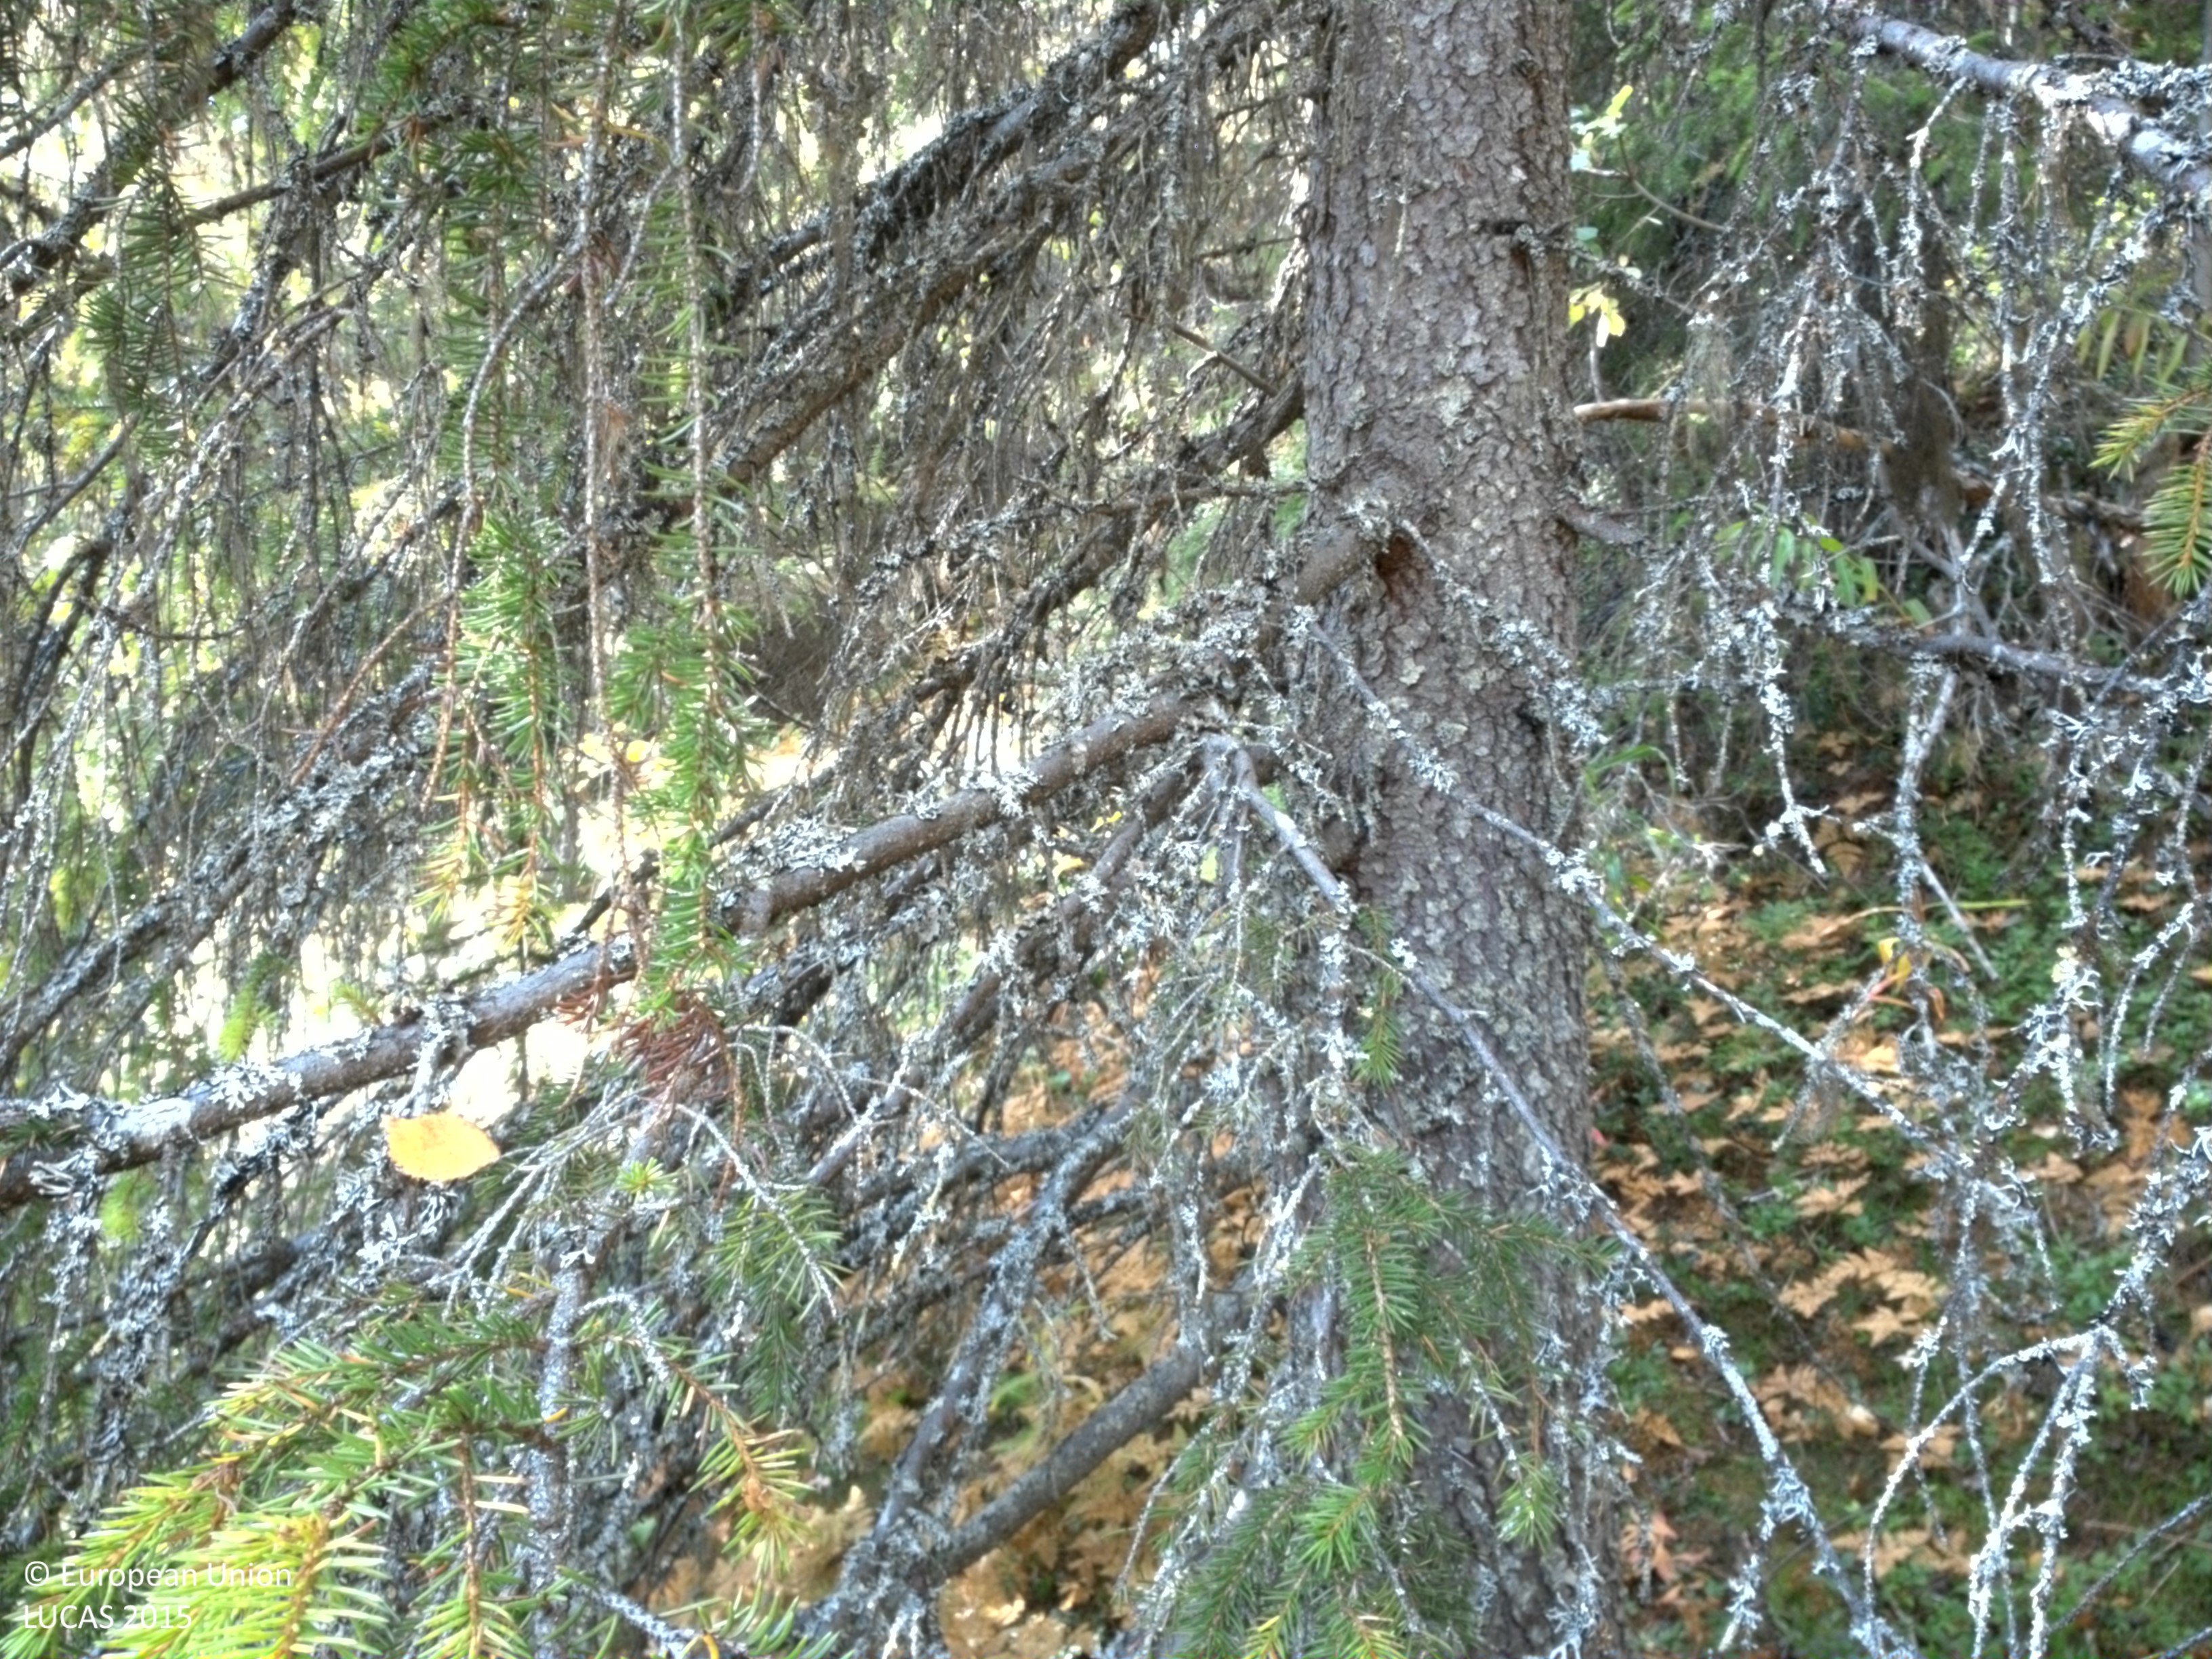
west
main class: Woodland
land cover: Spruce dominated mixed woodland
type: boreal forest
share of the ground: 25 - 50 %
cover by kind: shrubs 40 %, coniferous forest trees 20 %, broadleaved forest trees 15 %, herbaceous plants 15 %, lichens and mosses 10 %
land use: Forestry
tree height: > 5 m
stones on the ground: < 10 %
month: September
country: SE
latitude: 65.2828
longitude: 16.8851
